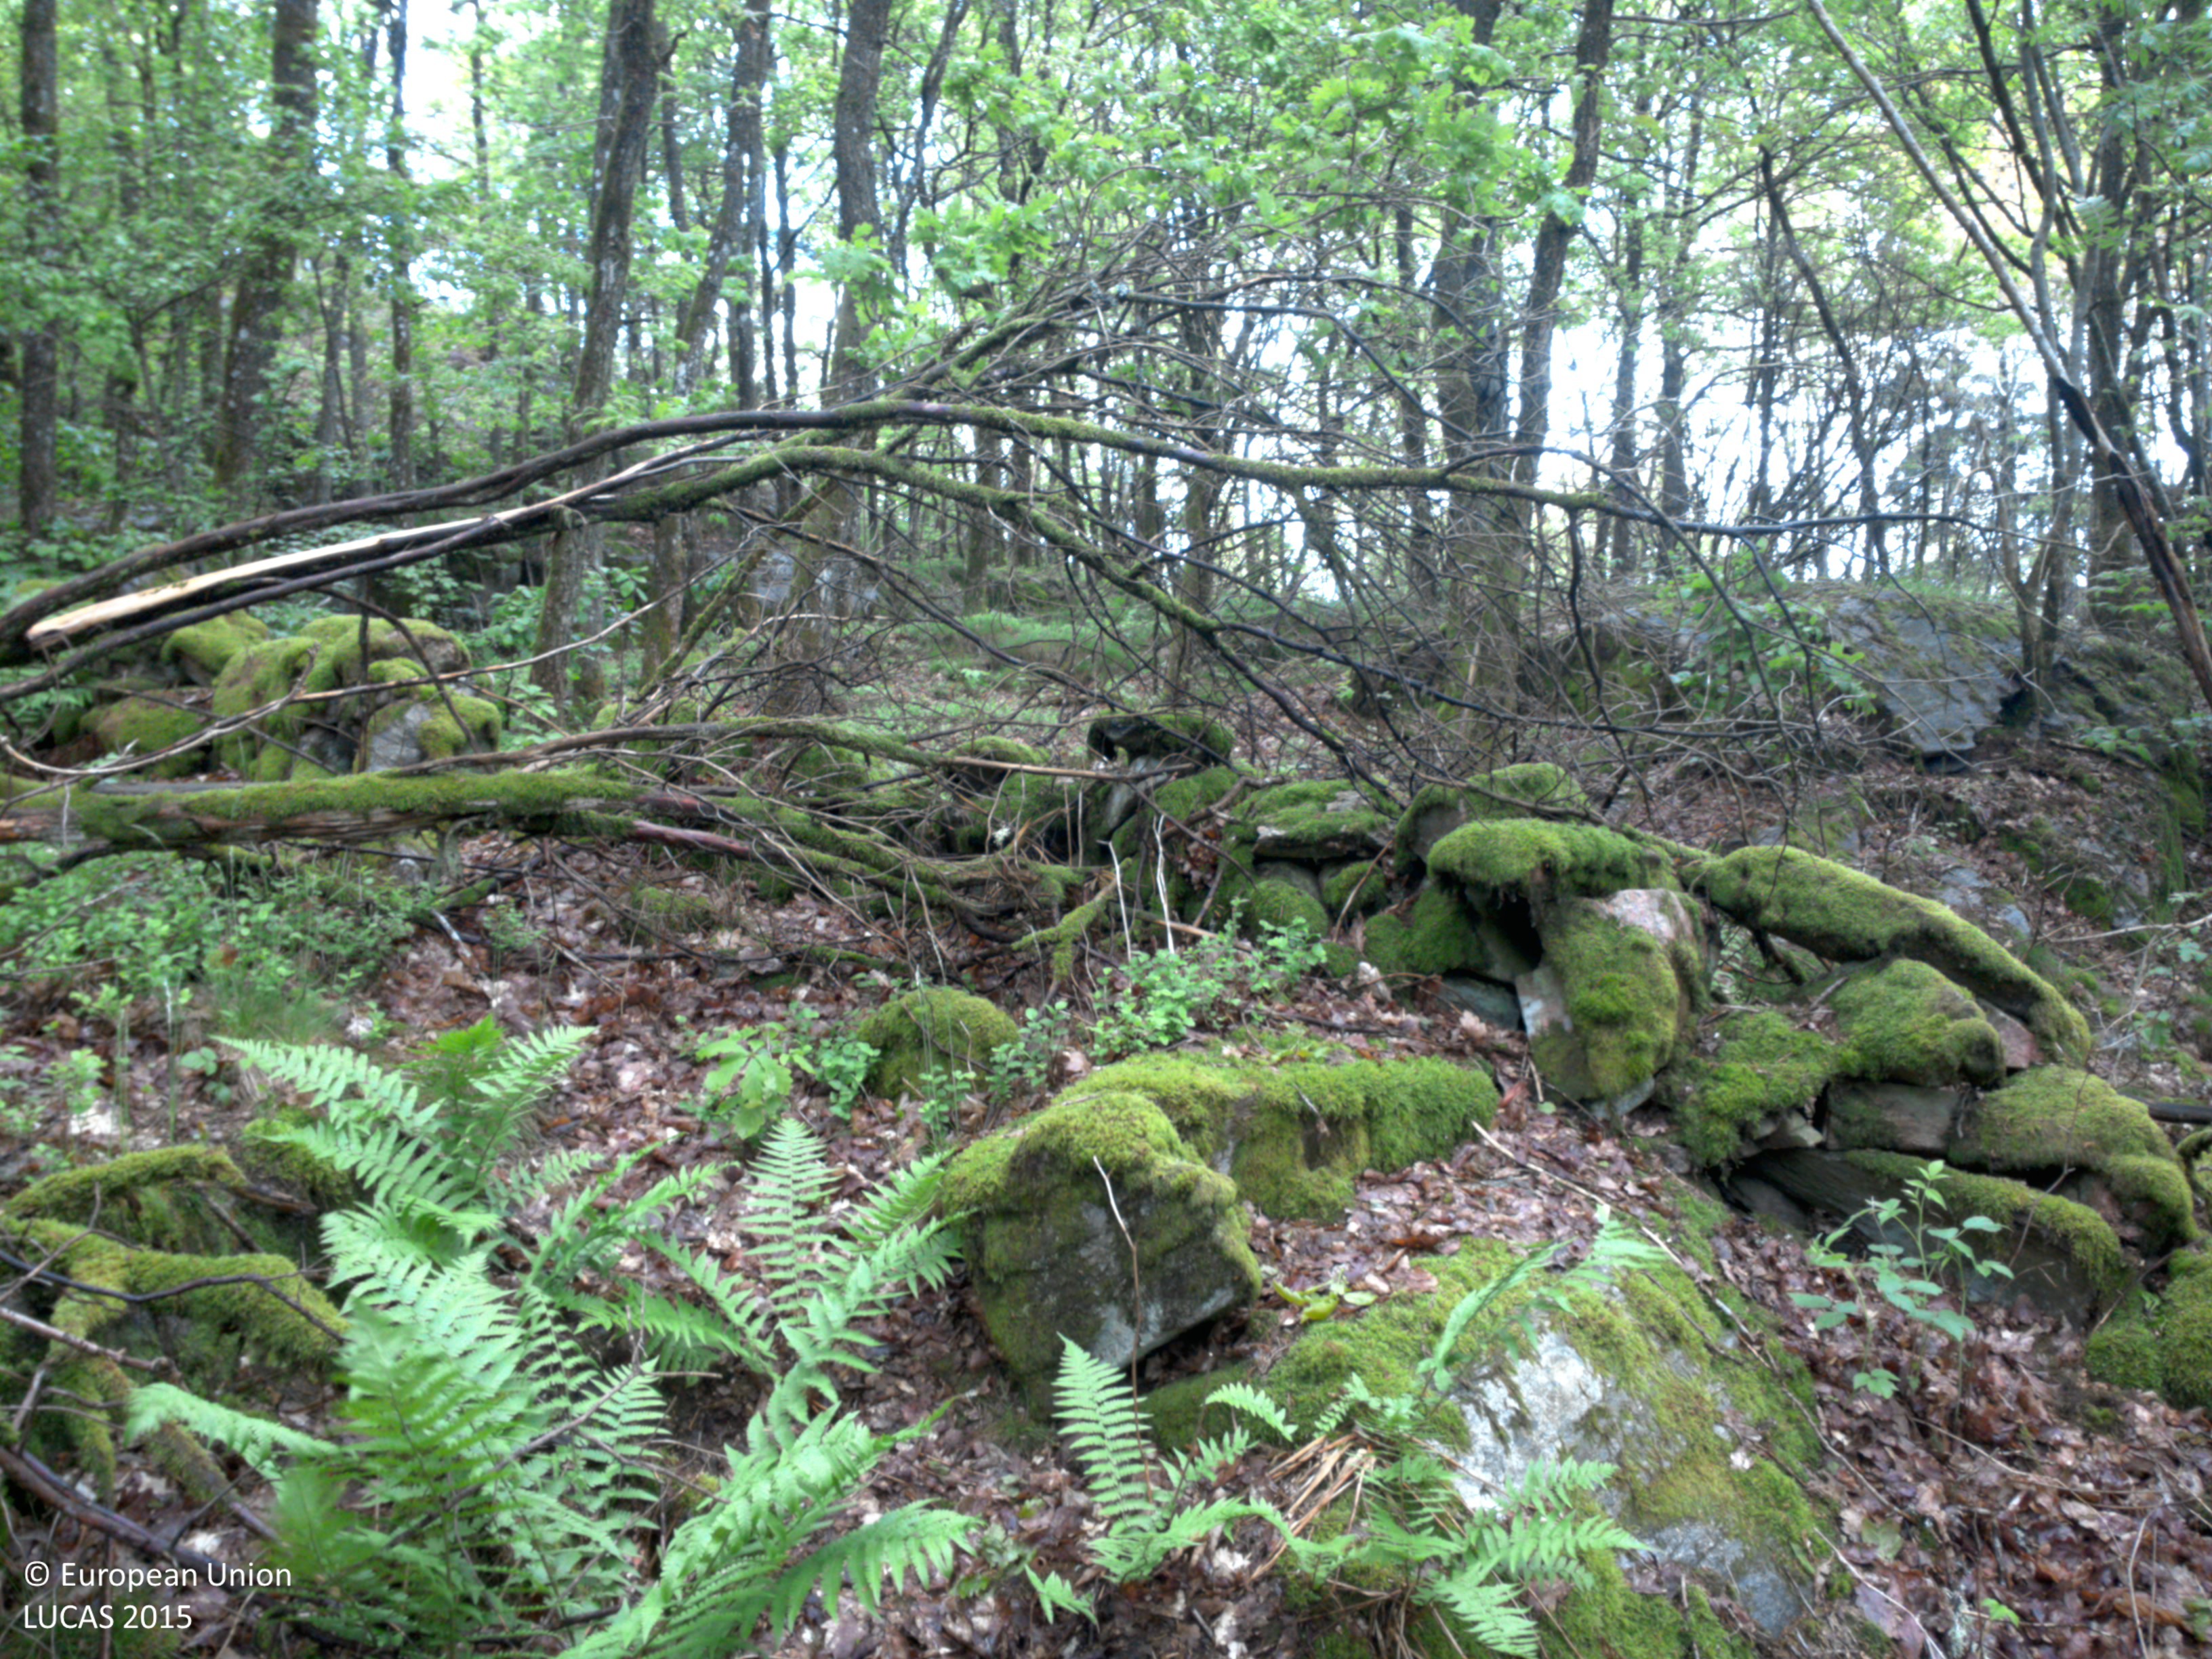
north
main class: Woodland
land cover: Broadleaved woodland
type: mesophytic deciduous forest
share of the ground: 50 - 75 %
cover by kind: broadleaved forest trees 70 %, herbaceous plants 20 %, shrubs 10 %
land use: Amenities, museums, leisure
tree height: > 5 m
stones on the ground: 10 - 25 %
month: June
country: SE
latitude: 57.8812
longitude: 11.9695
